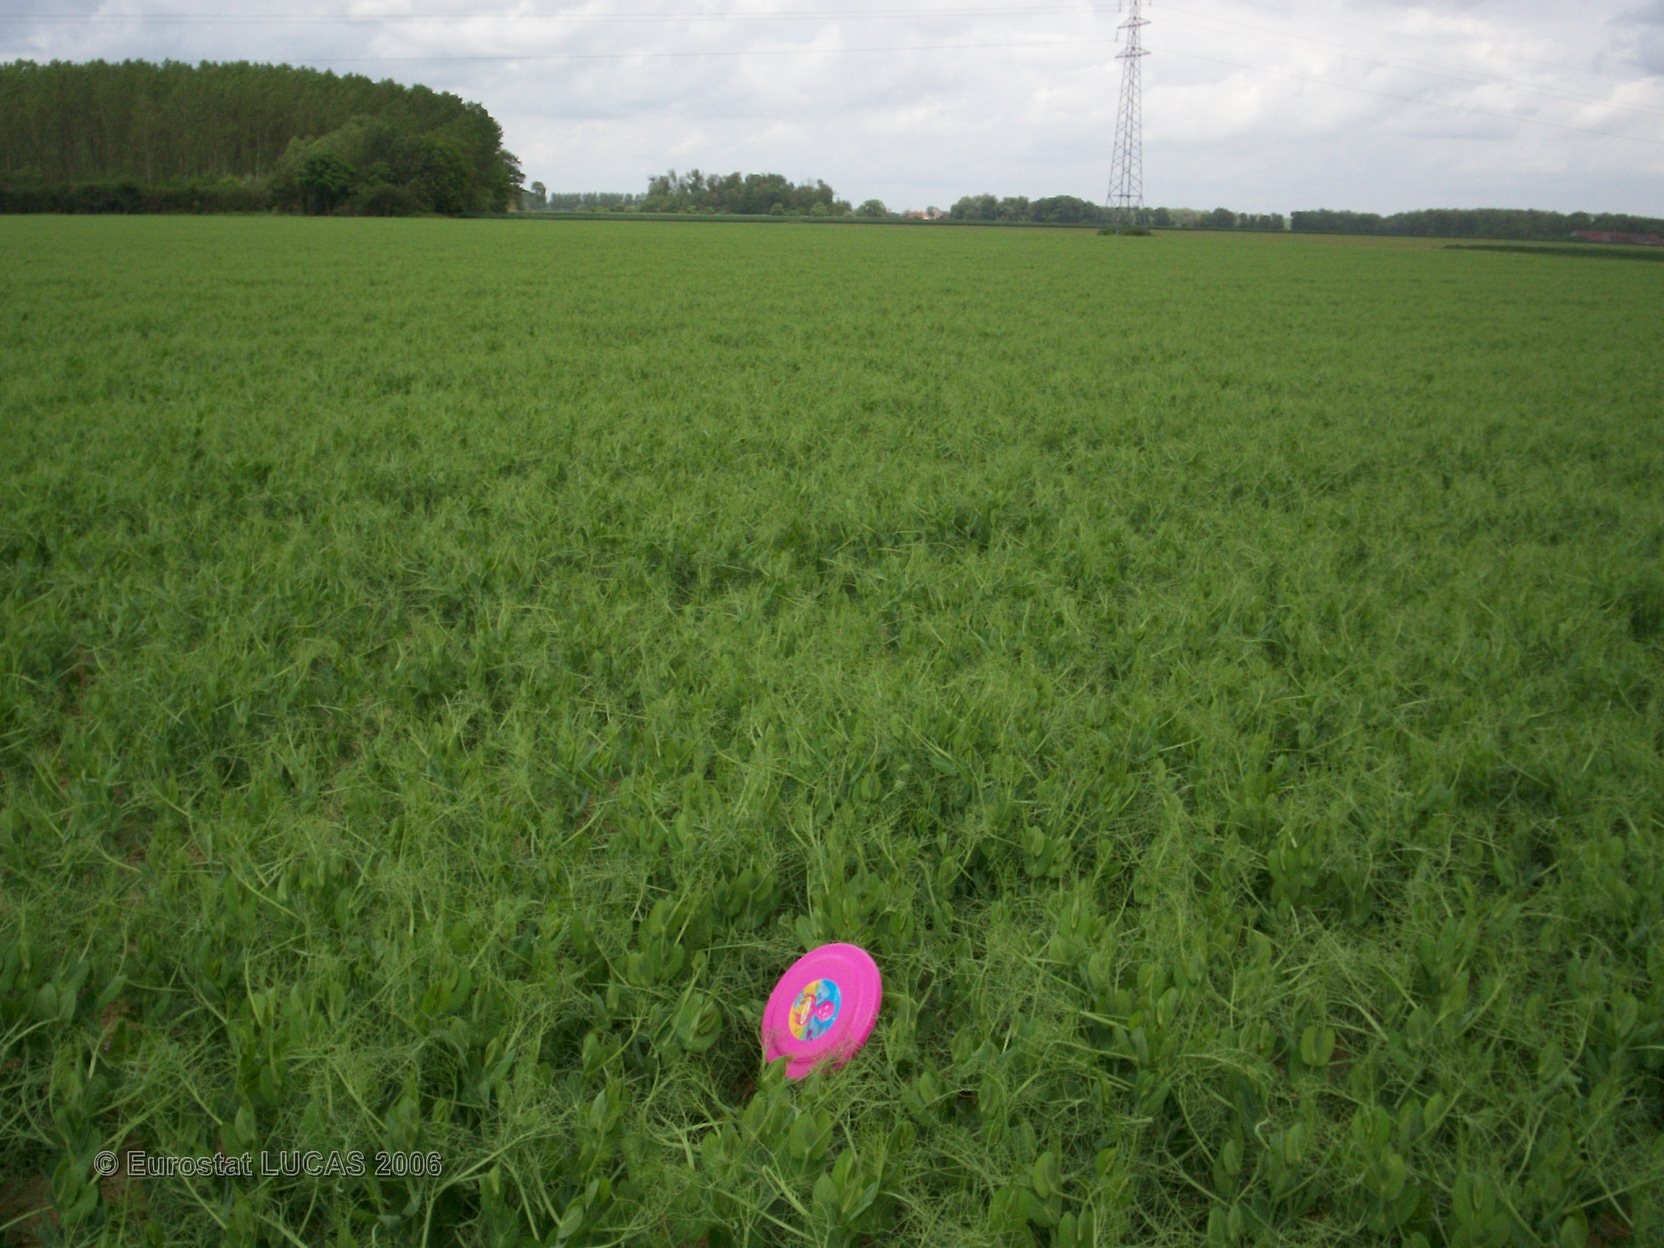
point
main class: Cropland
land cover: Dry pulses
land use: Agriculture (excluding fallow land and kitchen gardens)
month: May
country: FR
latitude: 48.7302
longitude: 2.8258
